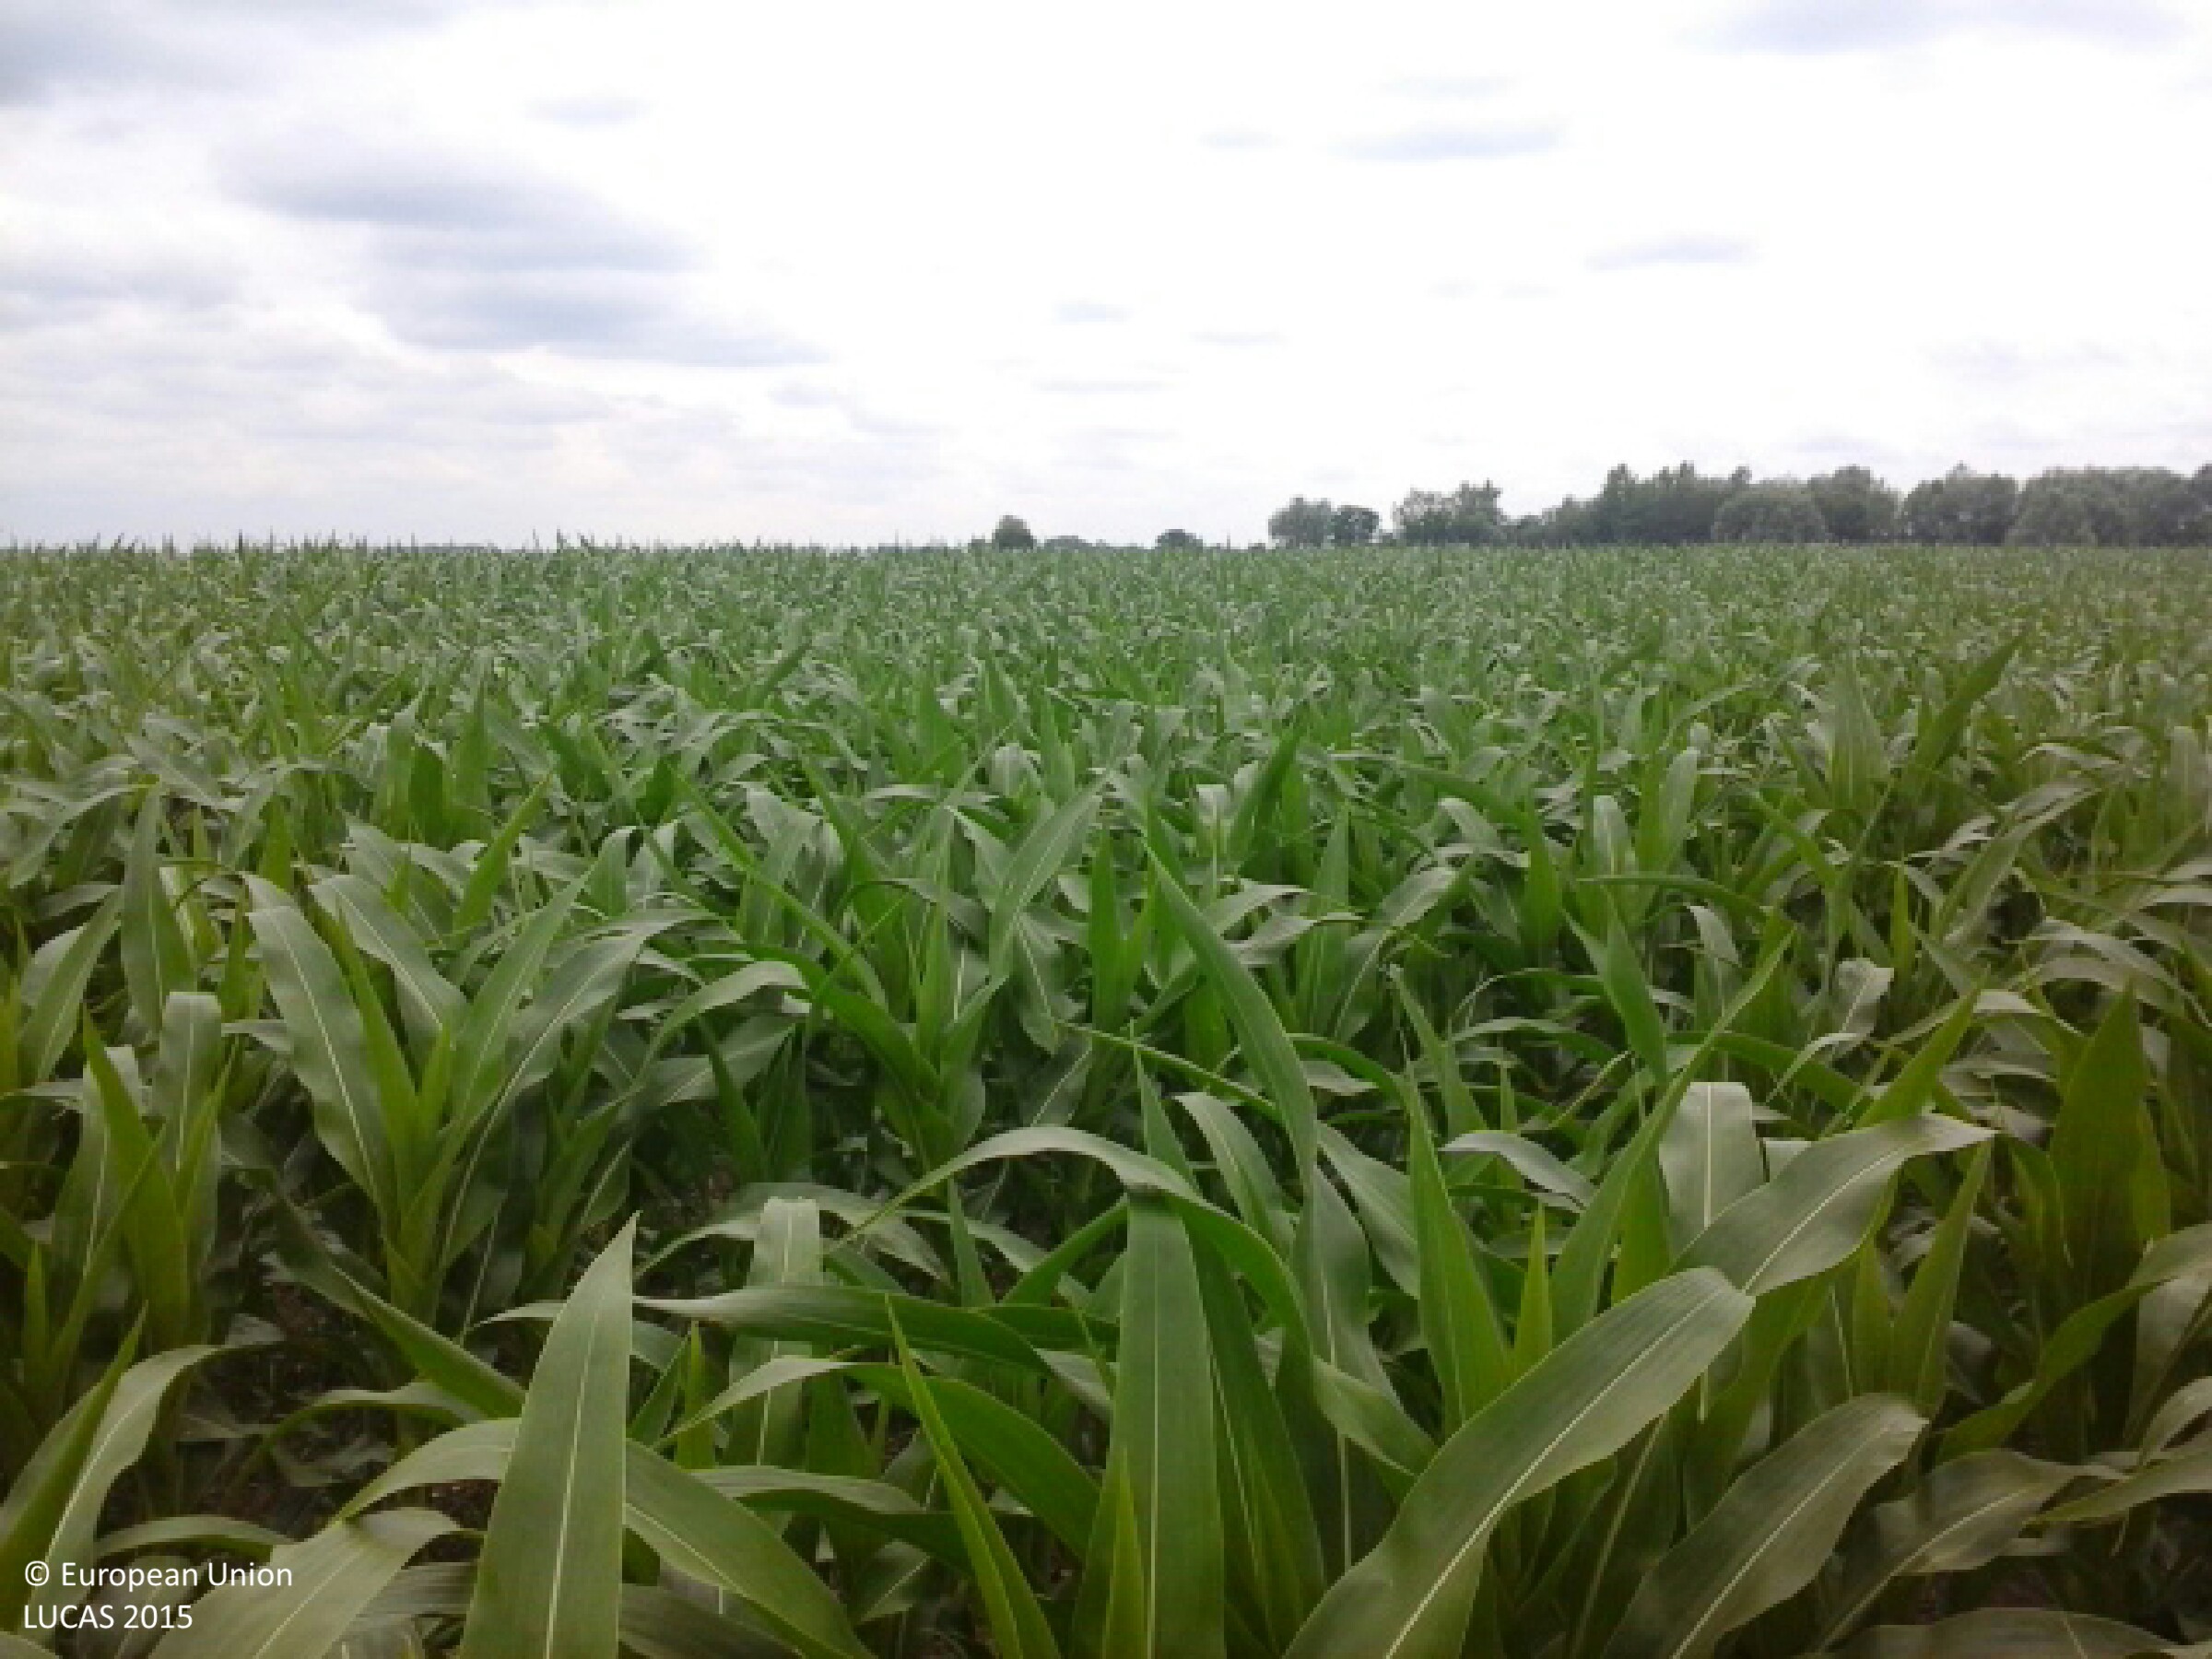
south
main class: Cropland
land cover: Maize
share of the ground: > 75 %
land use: Agriculture (excluding fallow land and kitchen gardens)
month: June
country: HU
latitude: 48.1675
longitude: 21.8154
